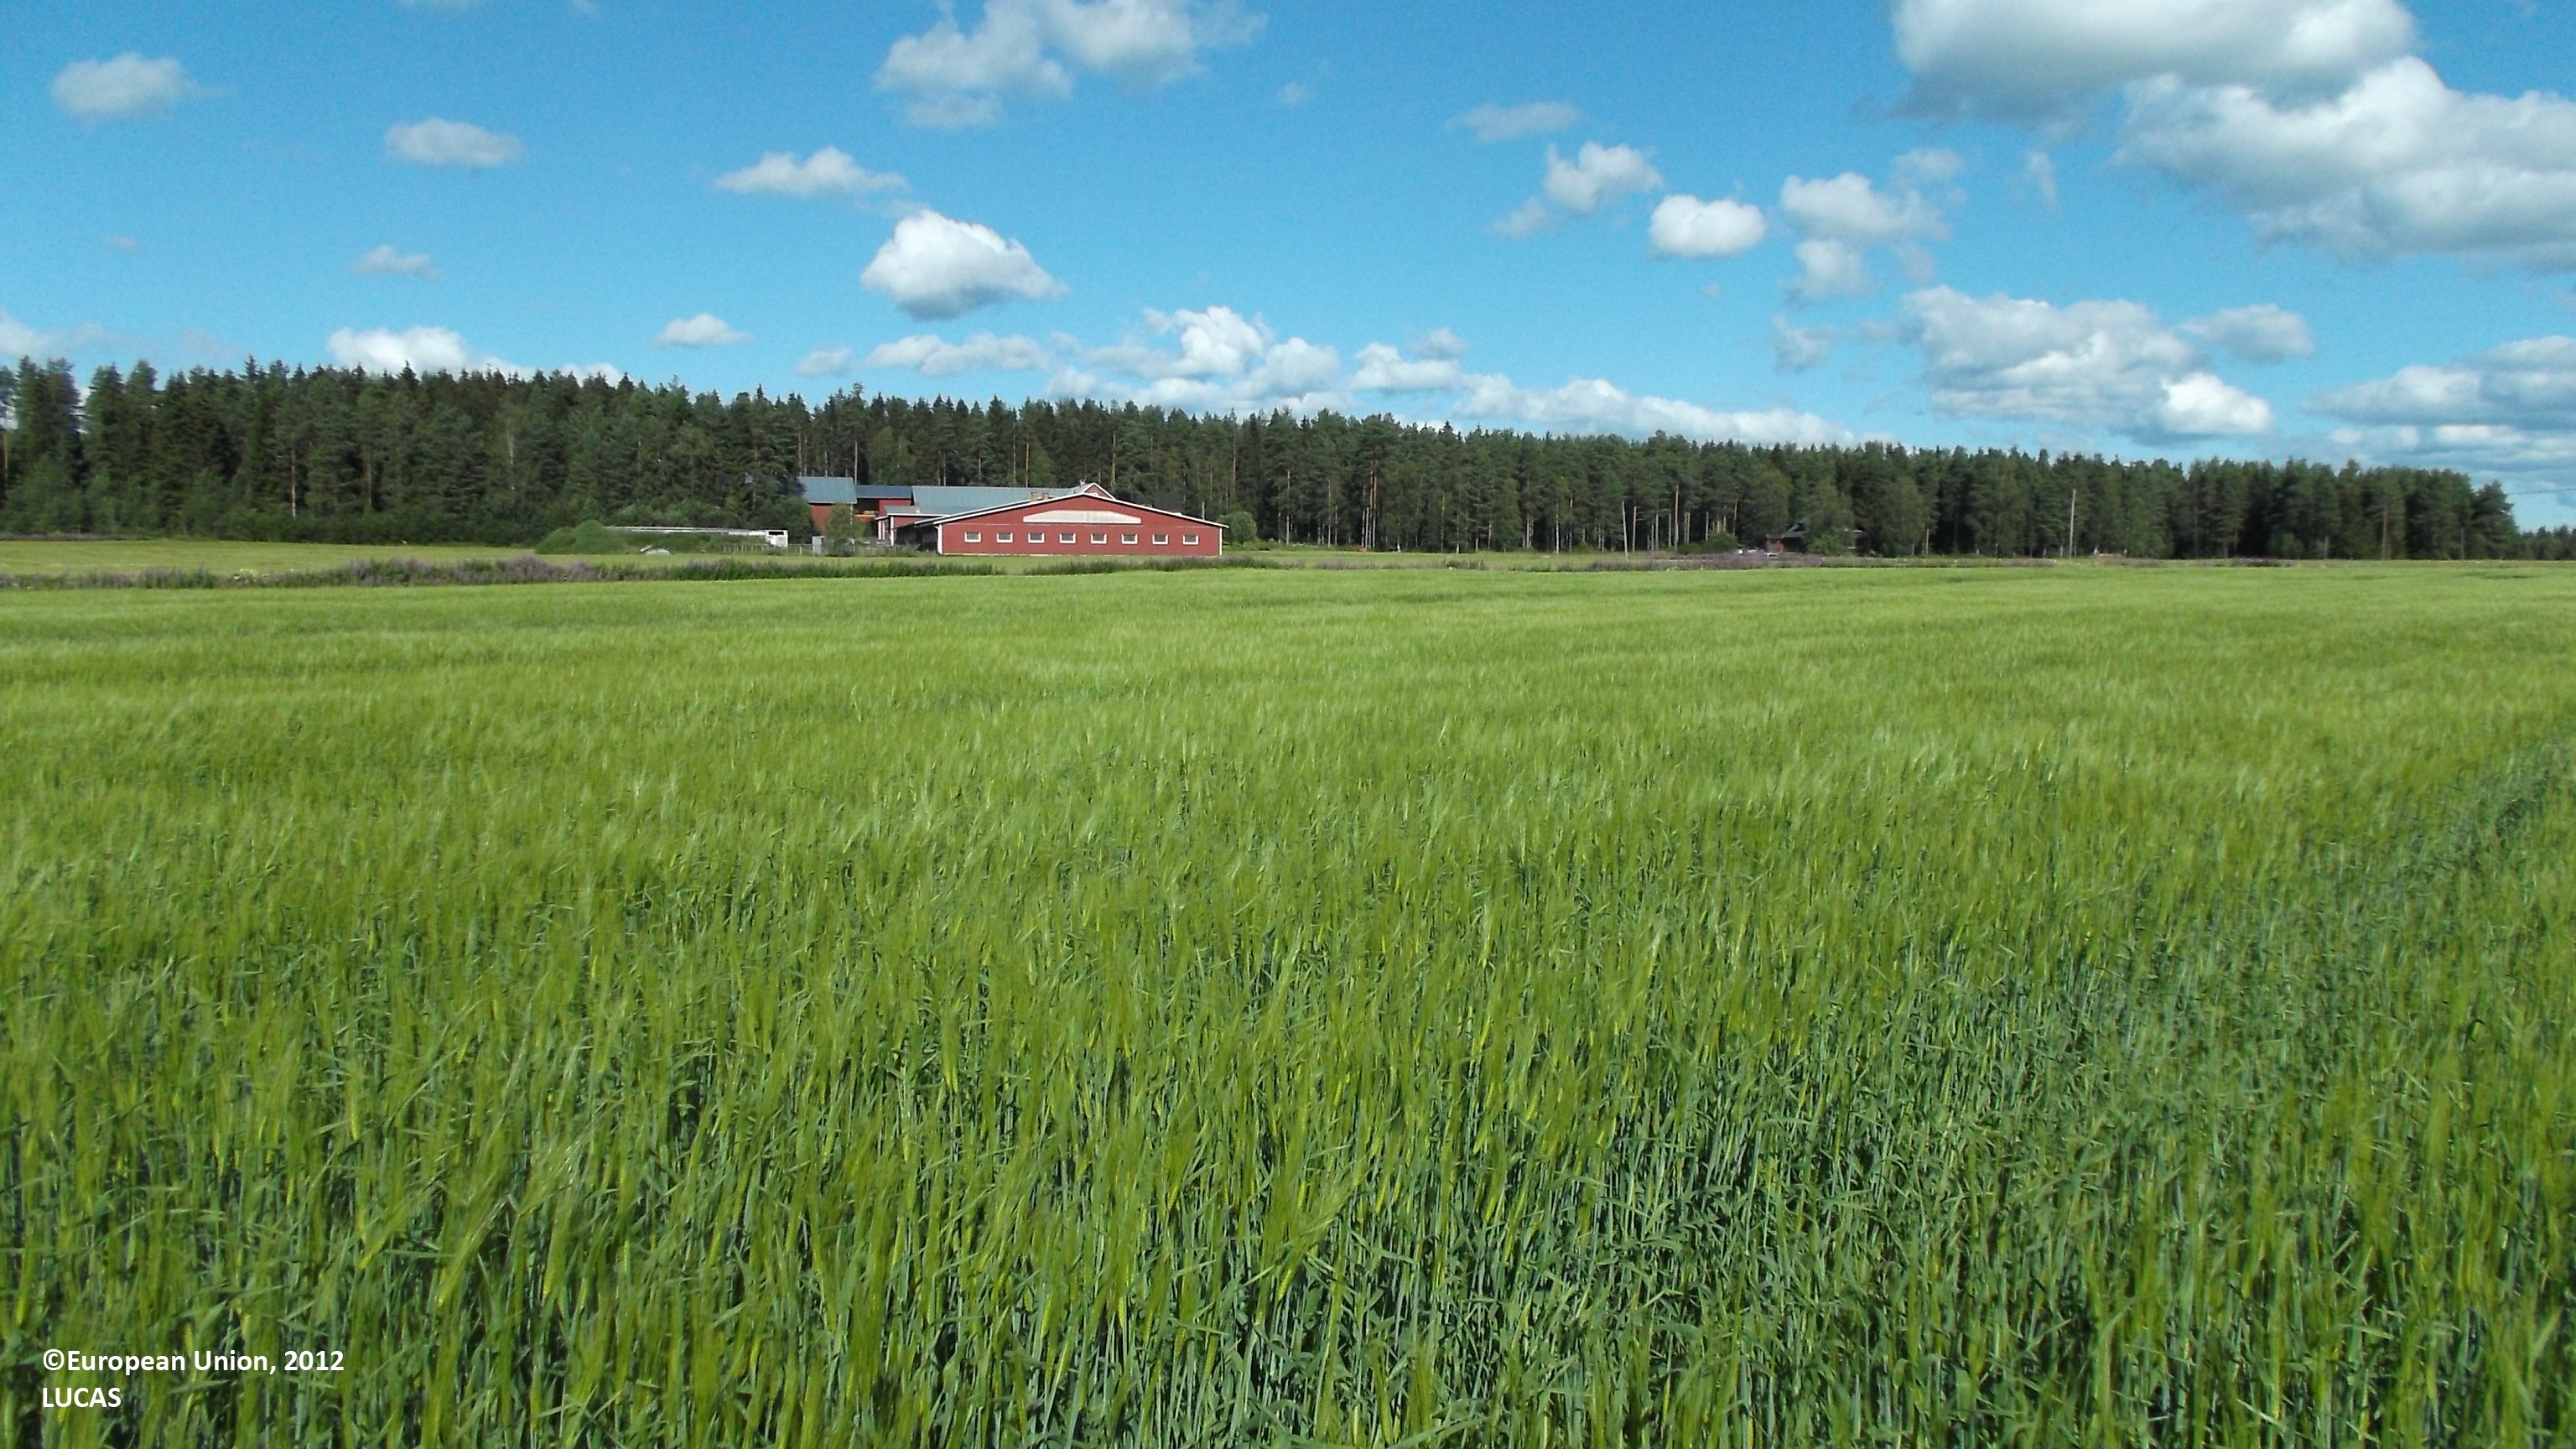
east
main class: Cropland
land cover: Barley
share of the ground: > 75 %
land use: Agriculture (excluding fallow land and kitchen gardens)
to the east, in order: Barley; Grass margins; Ditches and canals; Grassland without tree/shrub cover; Barley
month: July
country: FI
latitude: 63.5771
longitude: 22.8823
